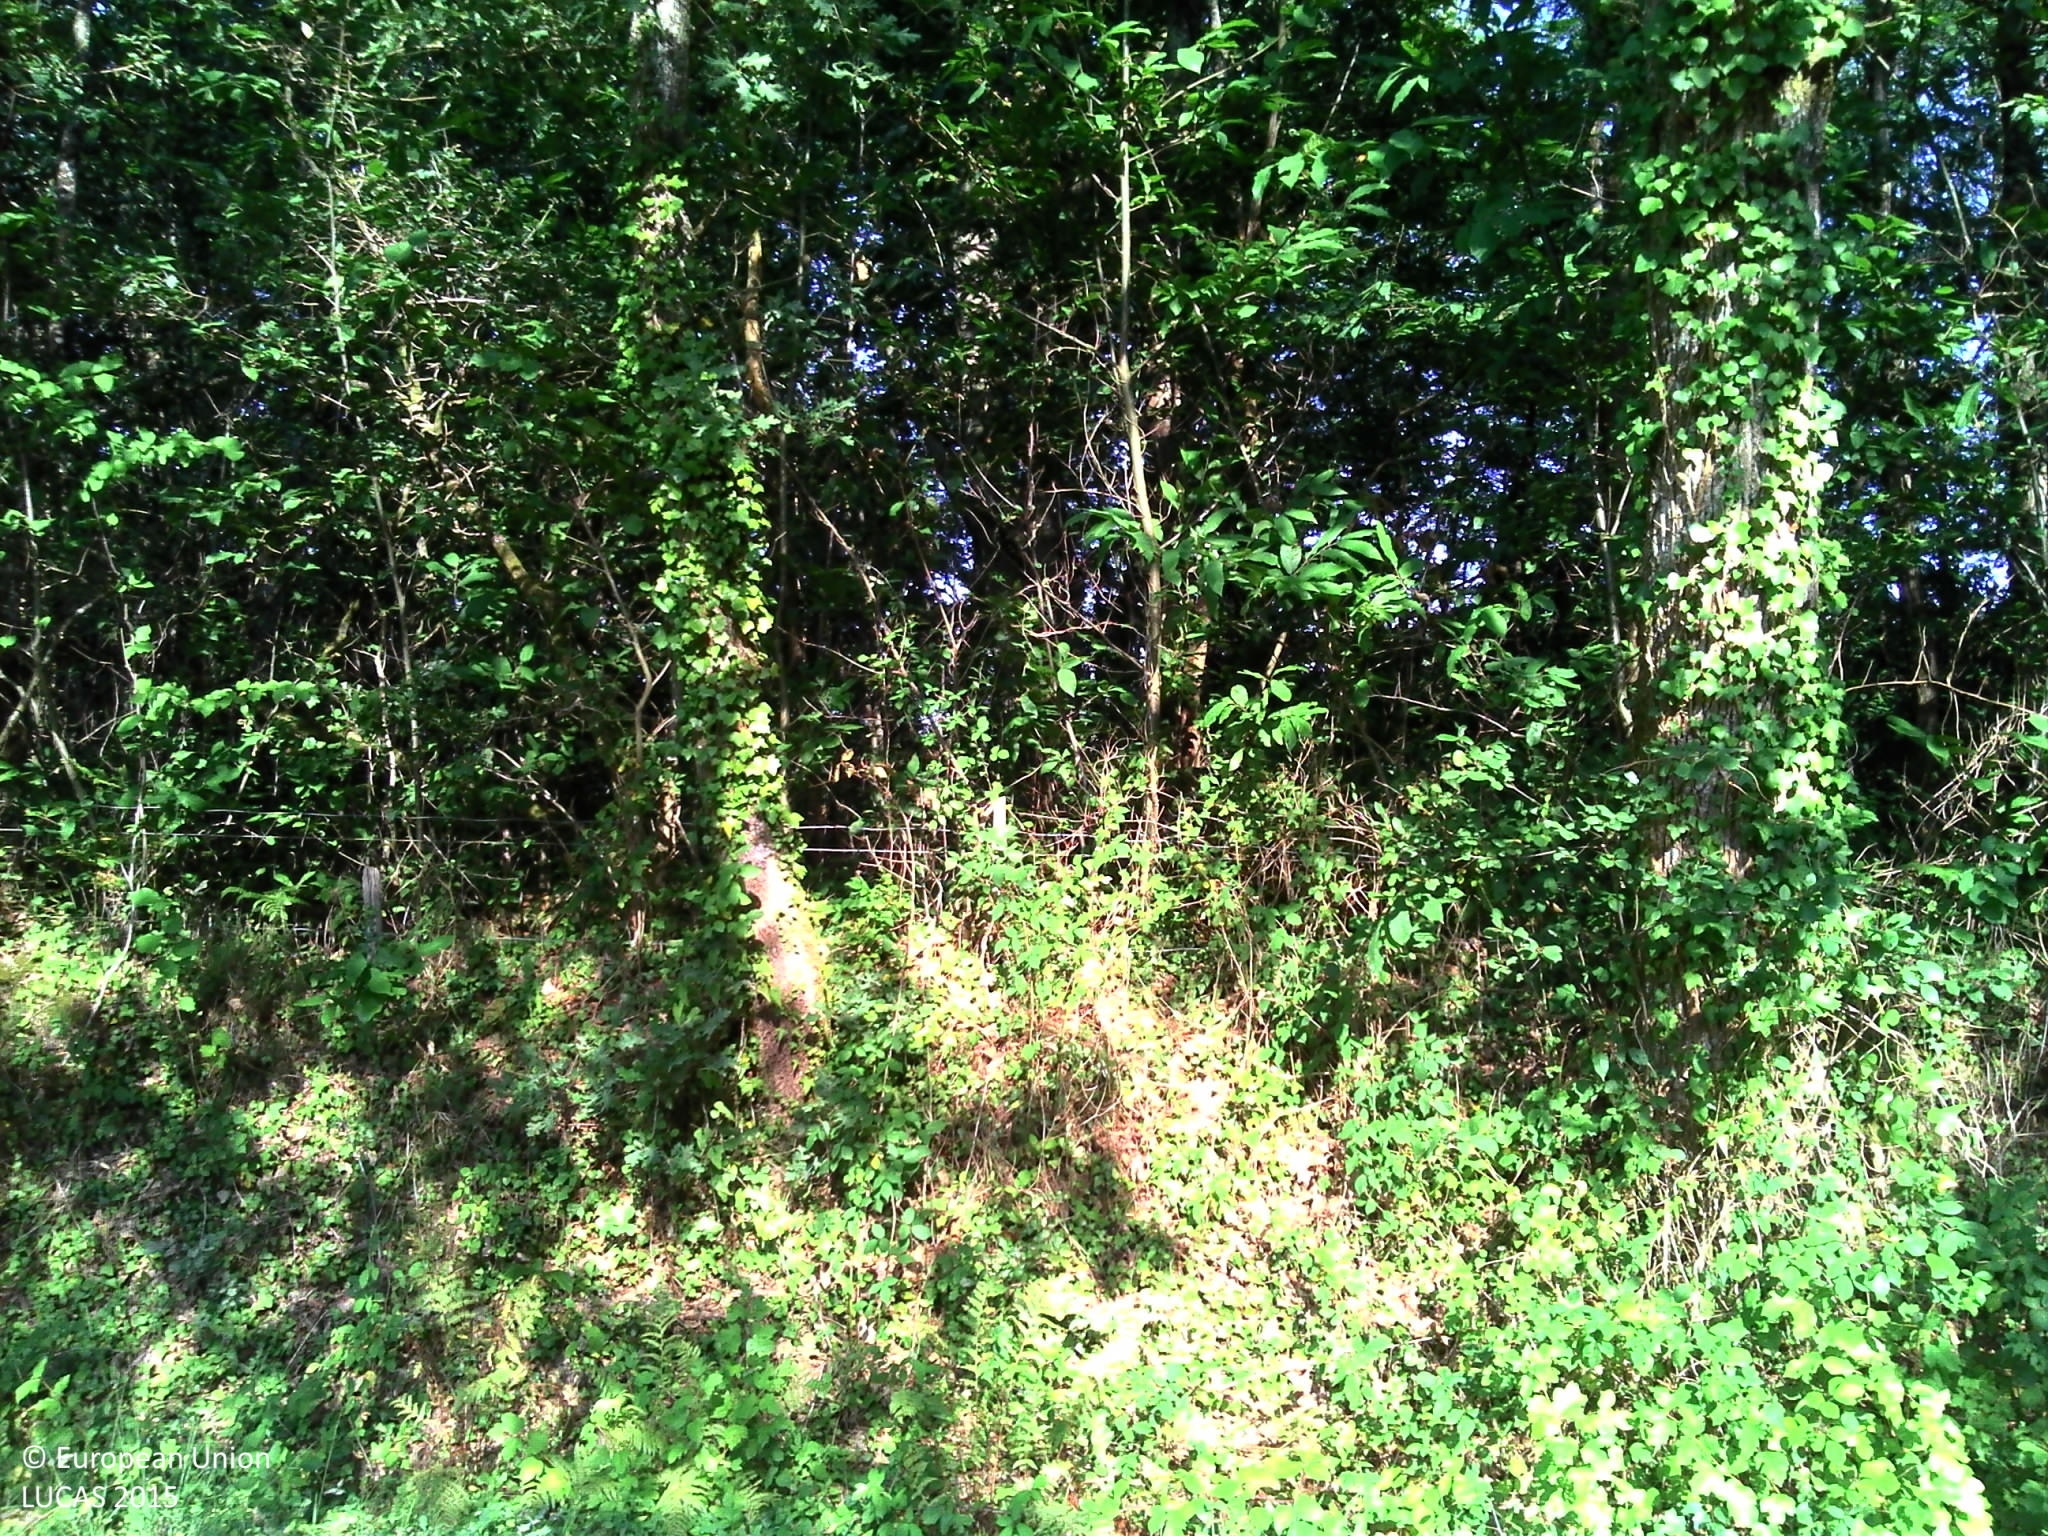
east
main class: Woodland
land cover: Broadleaved woodland
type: mesophytic deciduous forest
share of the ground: > 75 %
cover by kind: broadleaved forest trees 85 %, herbaceous plants 15 %
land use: Forestry
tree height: > 5 m
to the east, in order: Broadleaved woodland; Fences; Grassland without tree/shrub cover; Fences; Grass margins; Tracks; Grass margins; Ditches and canals; Fences; Broadleaved woodland; Fences; Grass margins; Tracks; Grass margins; Temporary grasslands; Shruby margins; Ditches and canals; Broadleaved woodland
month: August
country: FR
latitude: 43.7483
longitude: -0.8053
